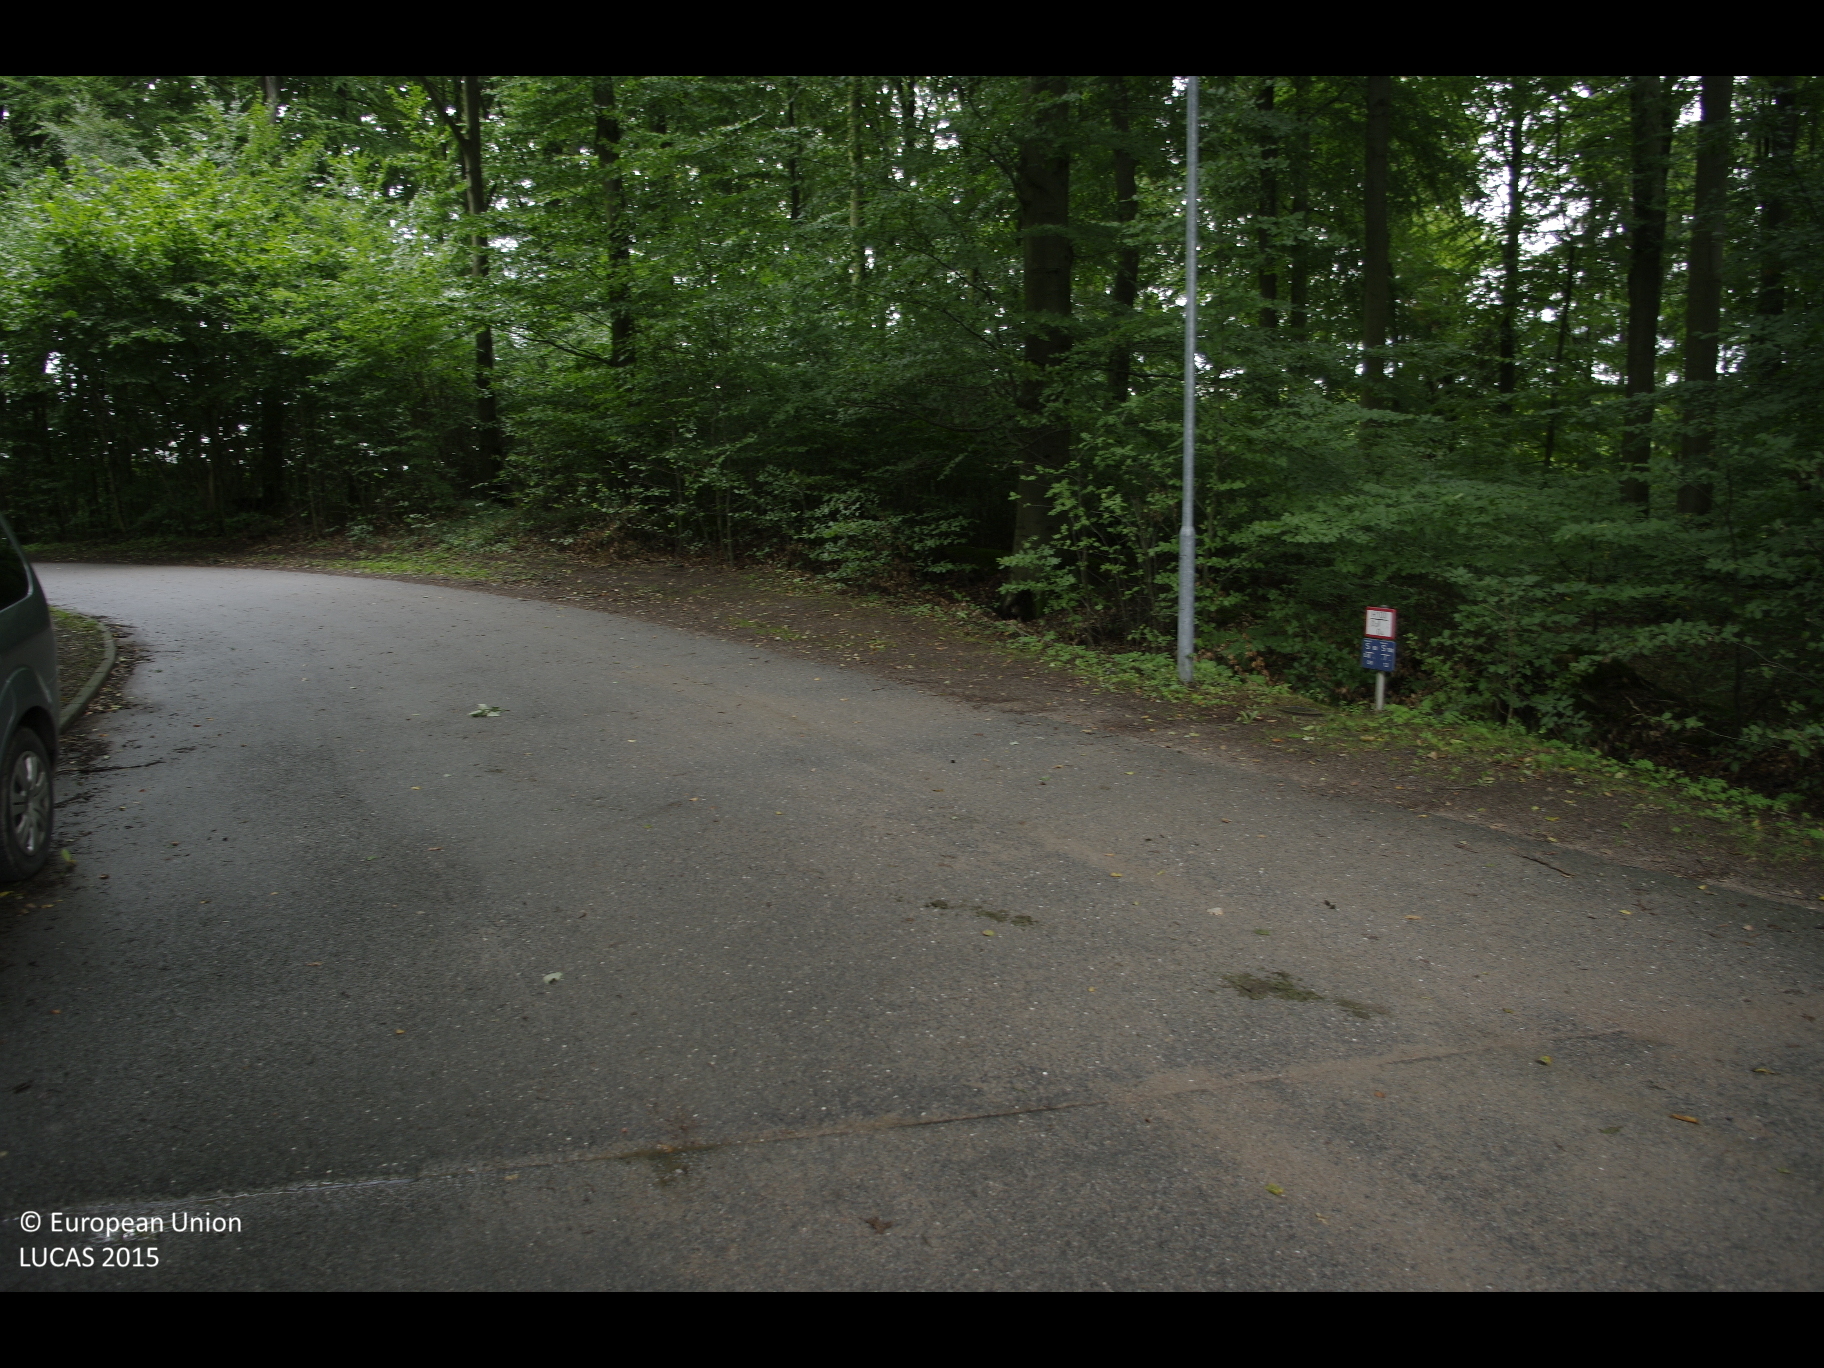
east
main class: Cropland
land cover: Apple fruit
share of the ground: 25 - 50 %
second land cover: Grassland without tree/shrub cover
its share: > 75 %
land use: Agriculture (excluding fallow land and kitchen gardens)
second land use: Amenities, museums, leisure
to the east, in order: Apple fruit; Grassland without tree/shrub cover; Spruce dominated mixed woodland; Grassland without tree/shrub cover; Fences; Abandoned hedges; Tracks; Broadleaved woodland; Fences; Tracks; Broadleaved woodland; Spruce dominated mixed woodland; Inland marshes
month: September
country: DE
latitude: 53.6529
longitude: 10.3780
